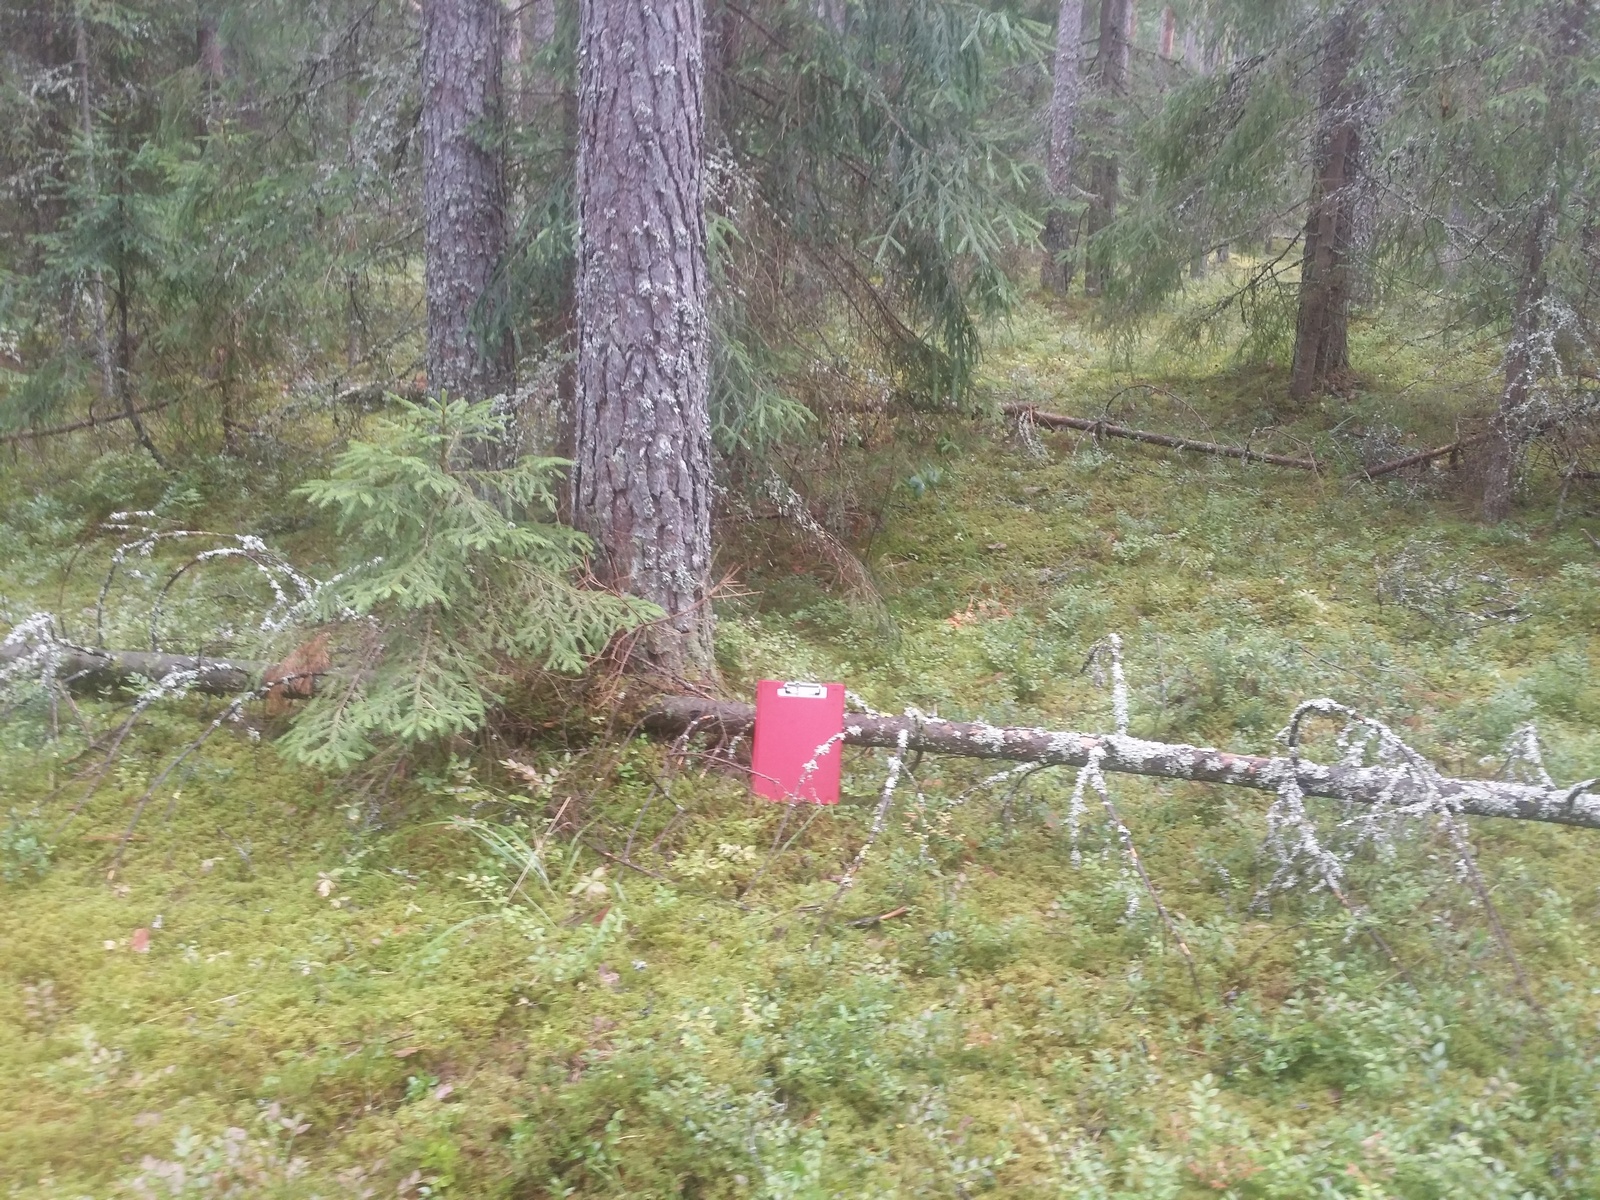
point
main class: Woodland
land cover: Other coniferous woodland
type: hemiboreal forest and nemoral coniferous forest and mixed broadleaved-coniferous forest
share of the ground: > 75 %
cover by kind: coniferous forest trees 80 %, lichens and mosses 15 %, herbaceous plants 5 %
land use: Forestry
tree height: > 5 m
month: August
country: LV
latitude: 57.4968
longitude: 26.6836
